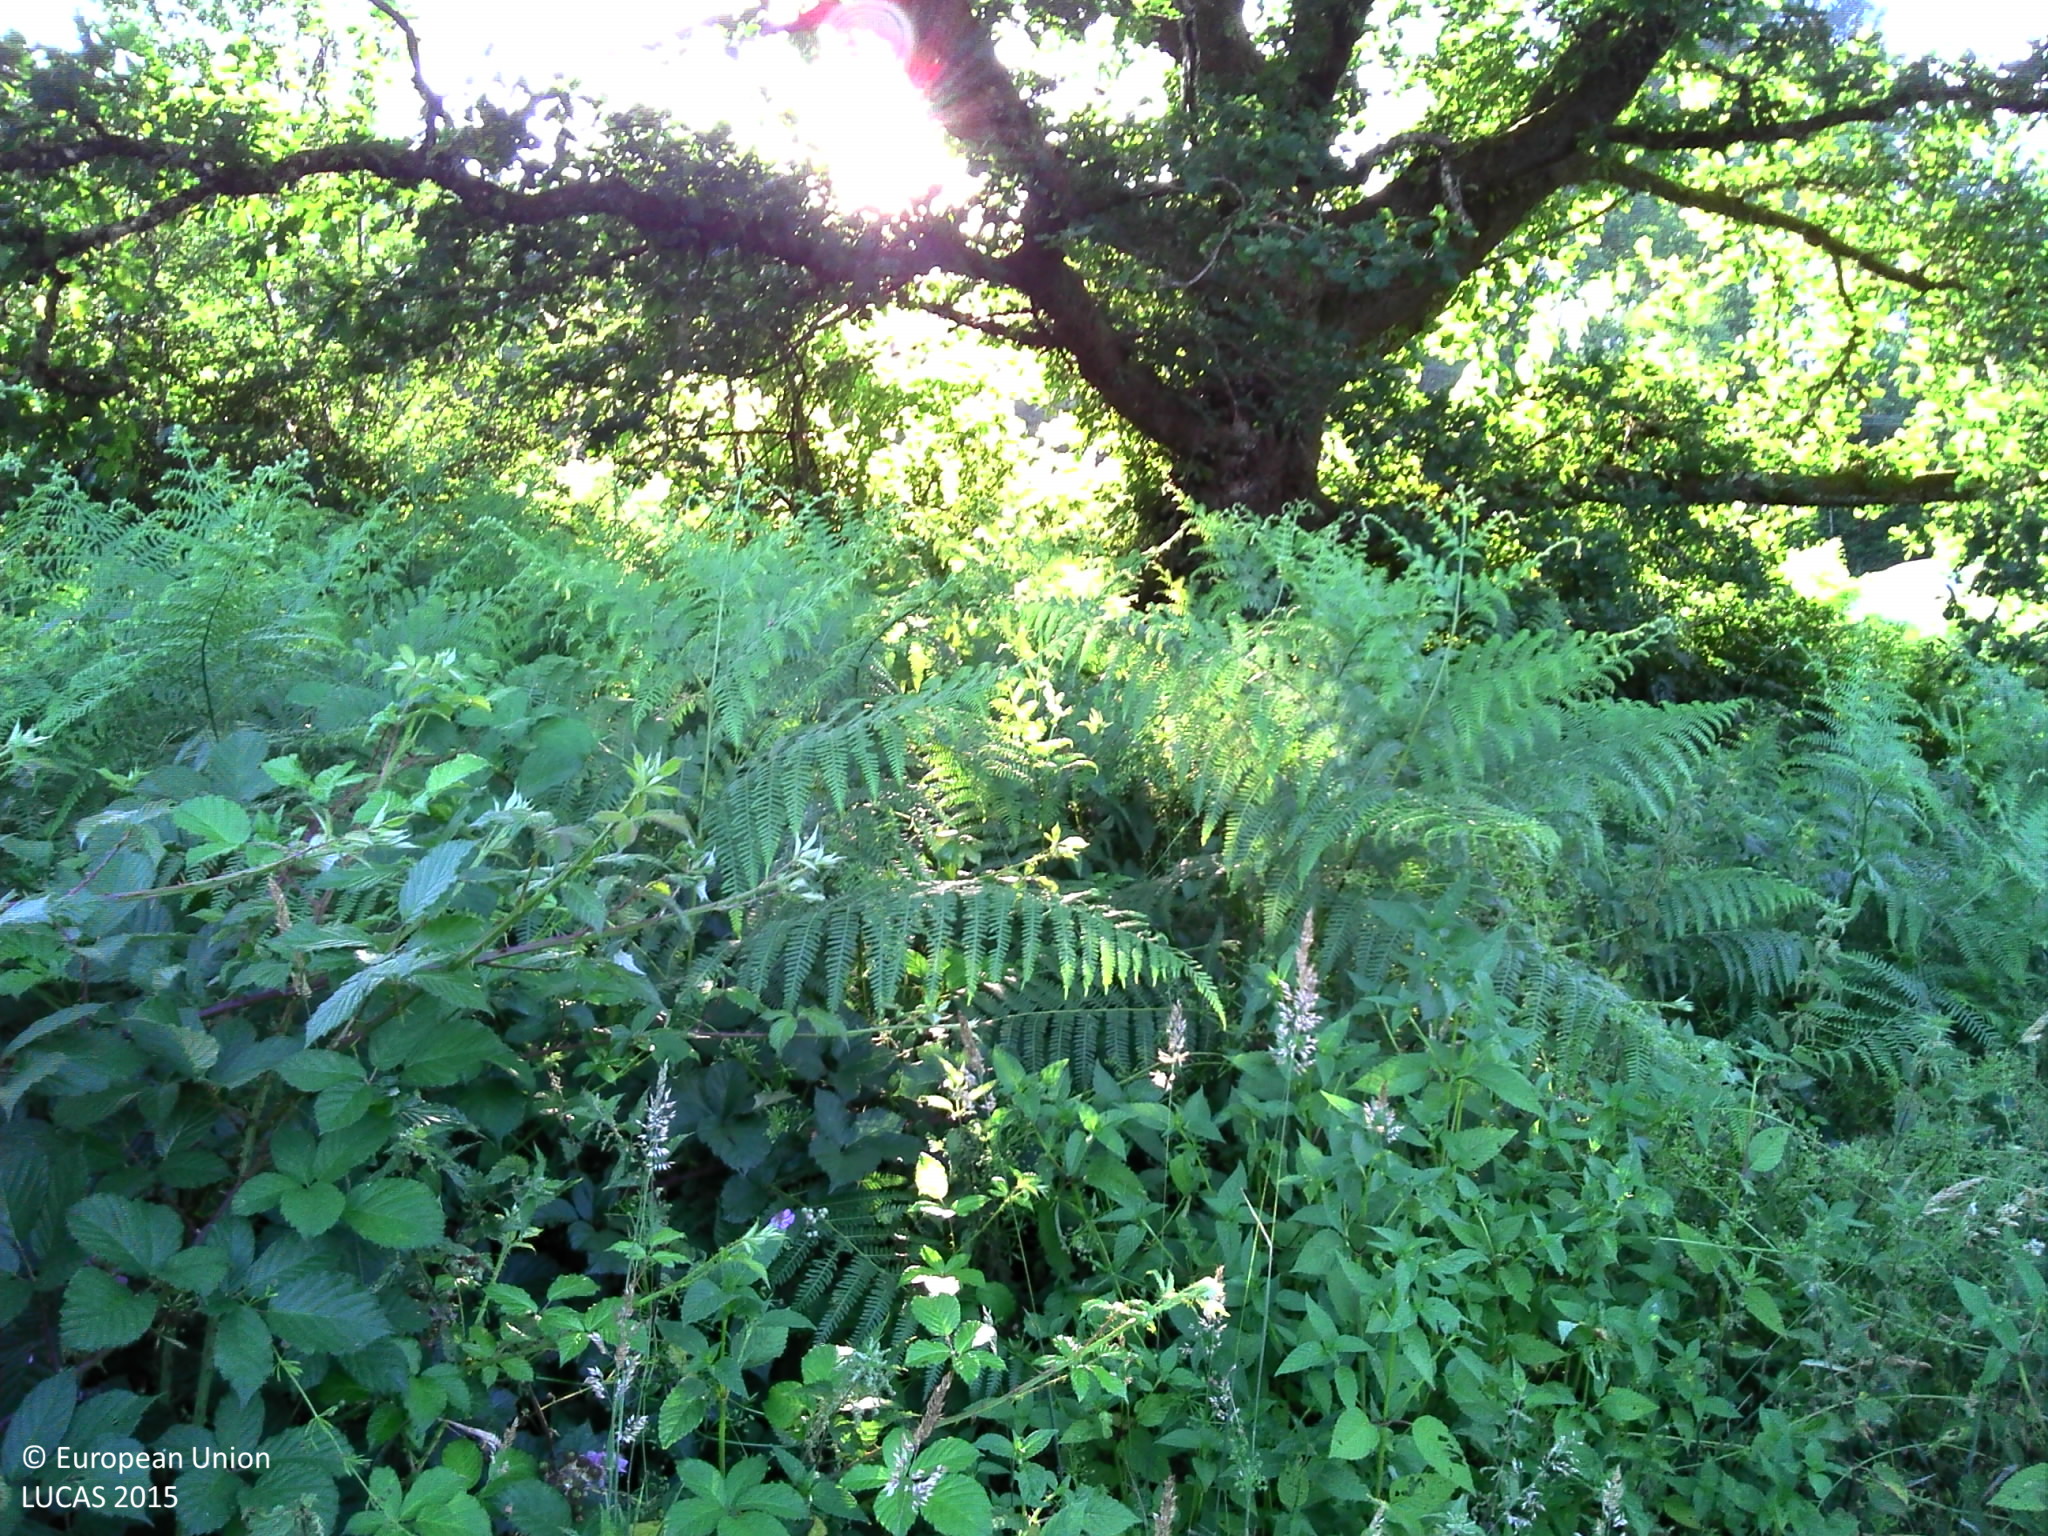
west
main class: Grassland
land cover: Spontaneously vegetated surfaces
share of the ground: > 75 %
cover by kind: herbaceous plants 95 %
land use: Agriculture (excluding fallow land and kitchen gardens)
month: July
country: FR
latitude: 45.6951
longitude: 1.8400
